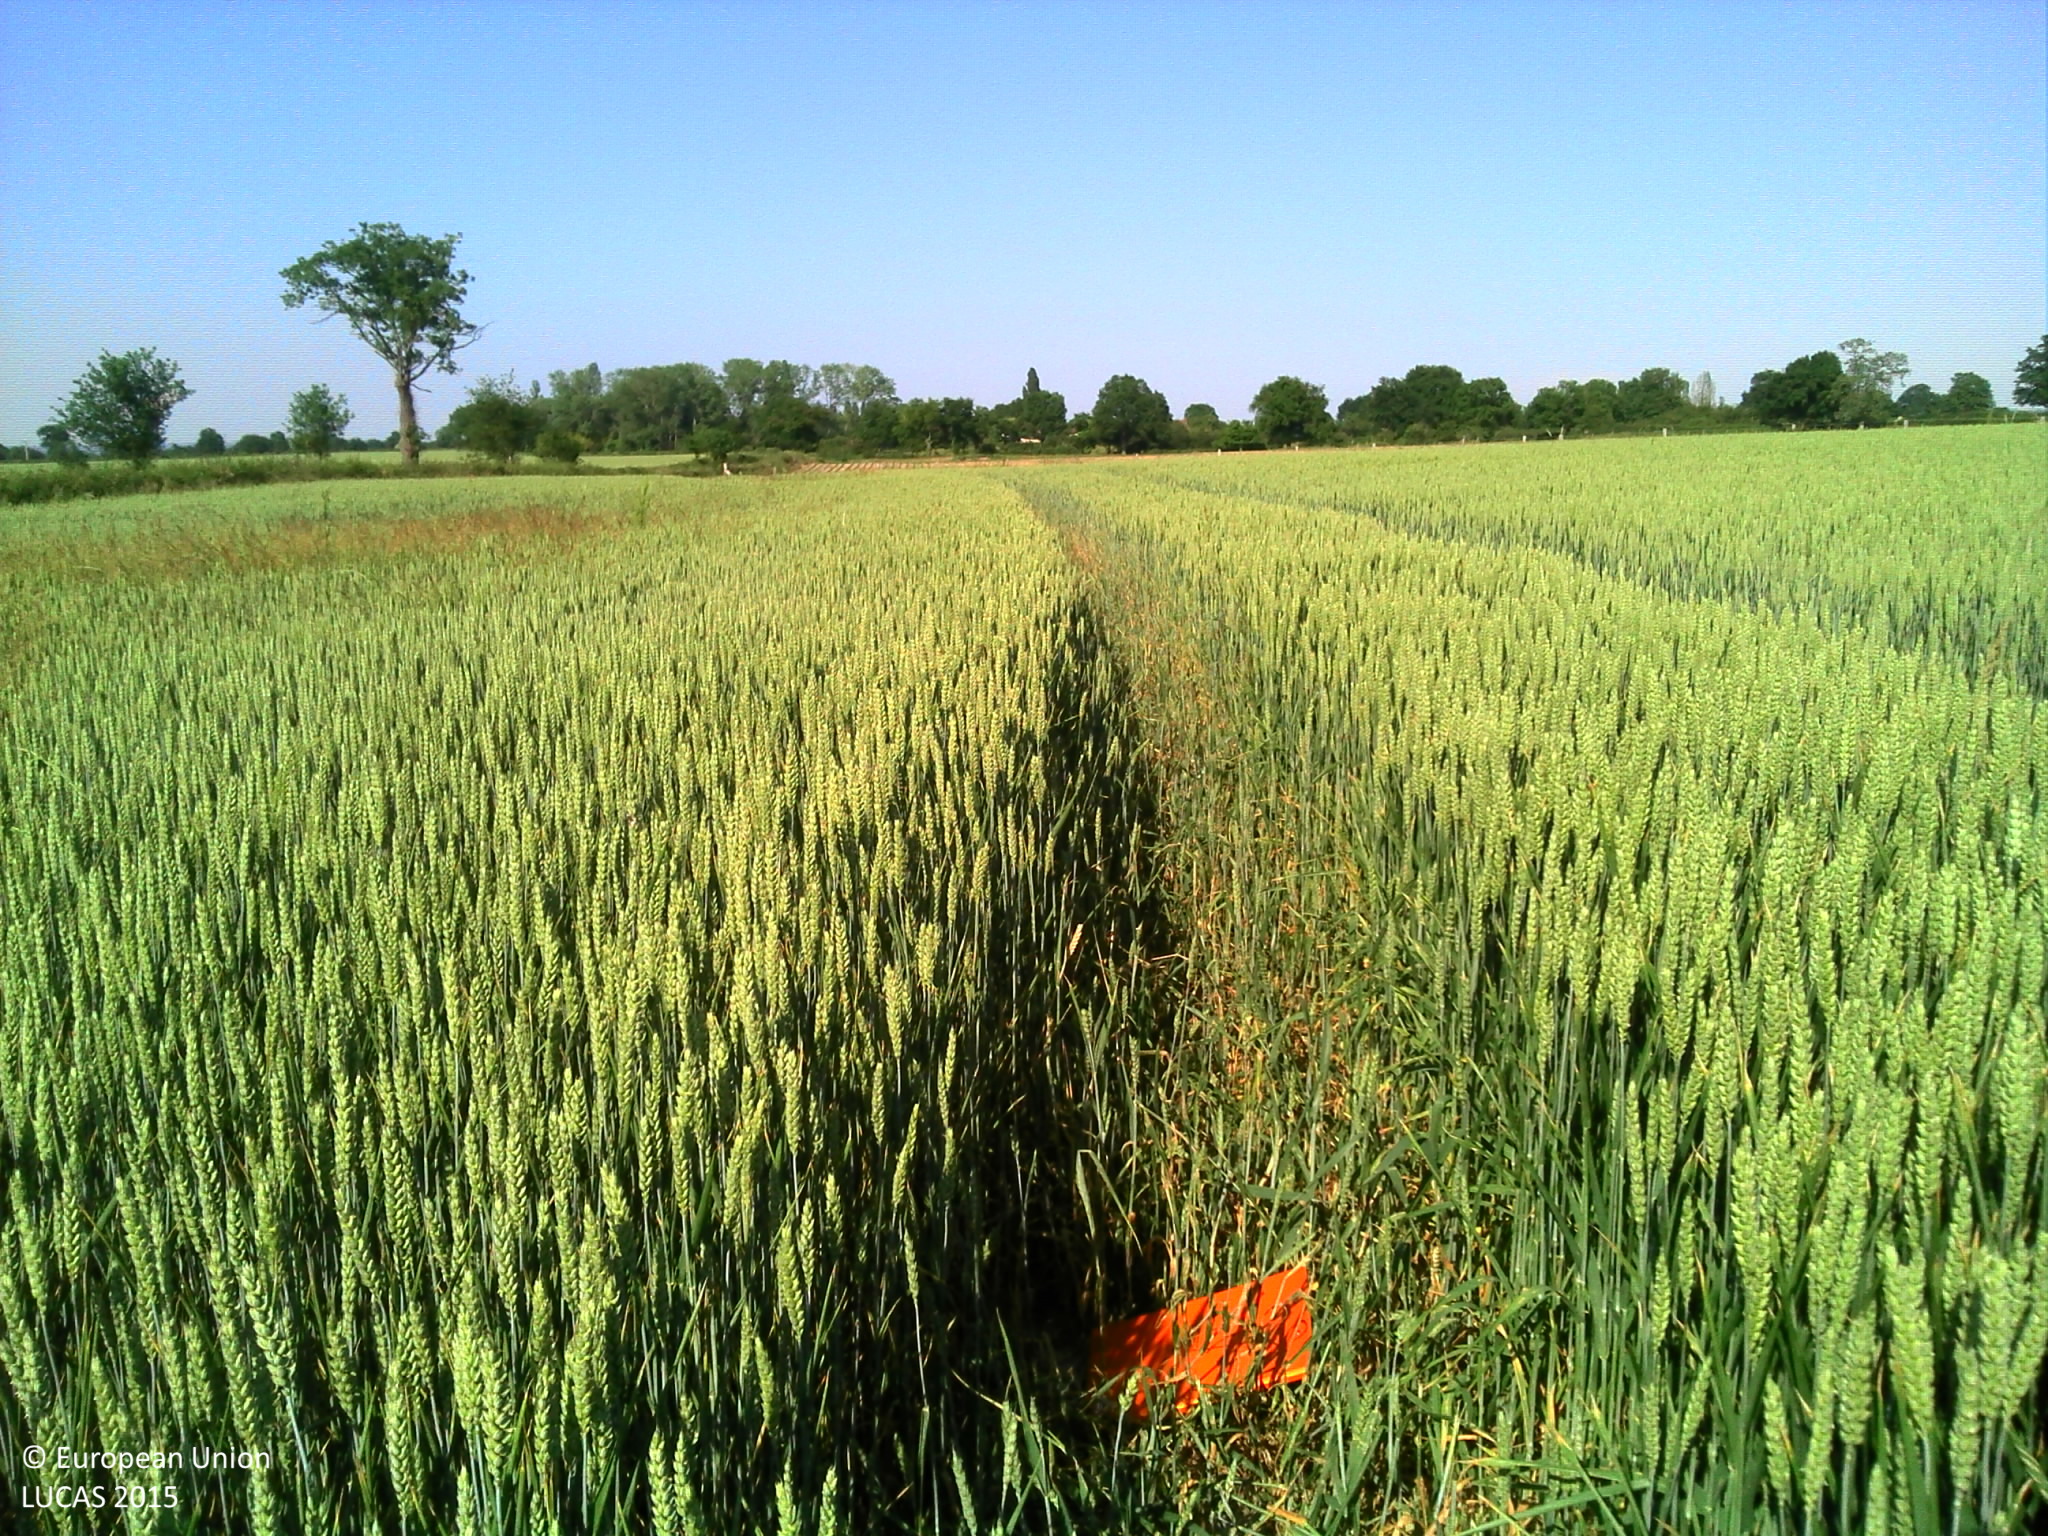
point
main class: Cropland
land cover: Common wheat
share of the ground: > 75 %
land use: Agriculture (excluding fallow land and kitchen gardens)
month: June
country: FR
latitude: 46.3927
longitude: 2.7267
